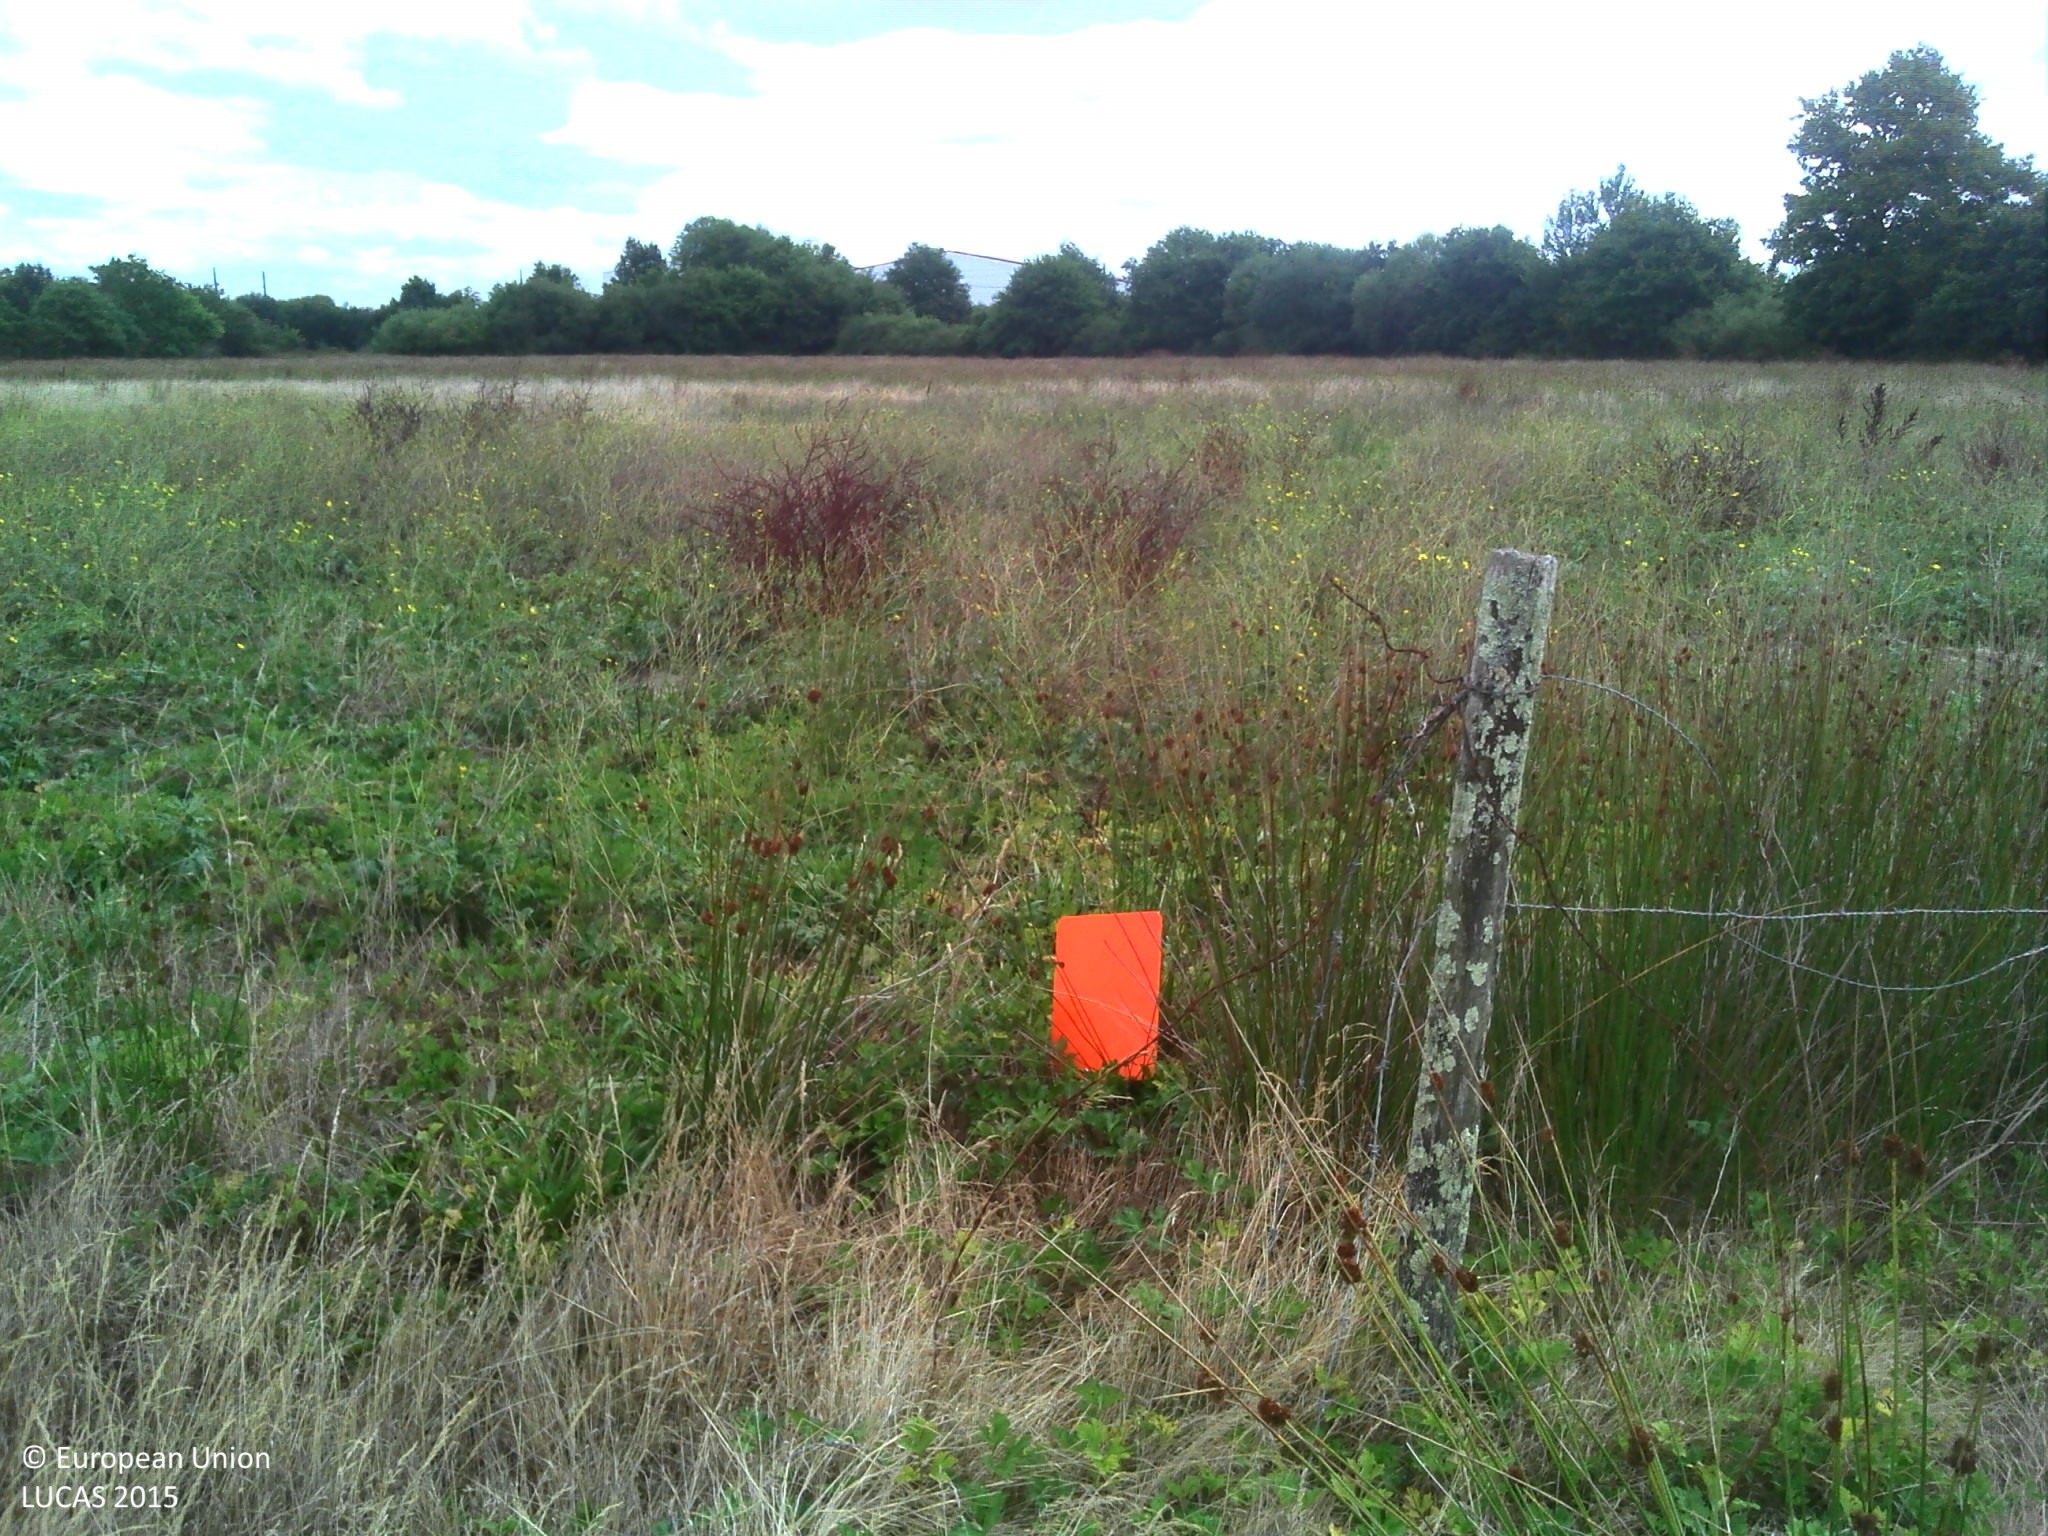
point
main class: Grassland
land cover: Grassland without tree/shrub cover
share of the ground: > 75 %
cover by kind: herbaceous plants 100 %
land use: Agriculture (excluding fallow land and kitchen gardens)
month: August
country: FR
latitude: 46.7356
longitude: -1.4369
